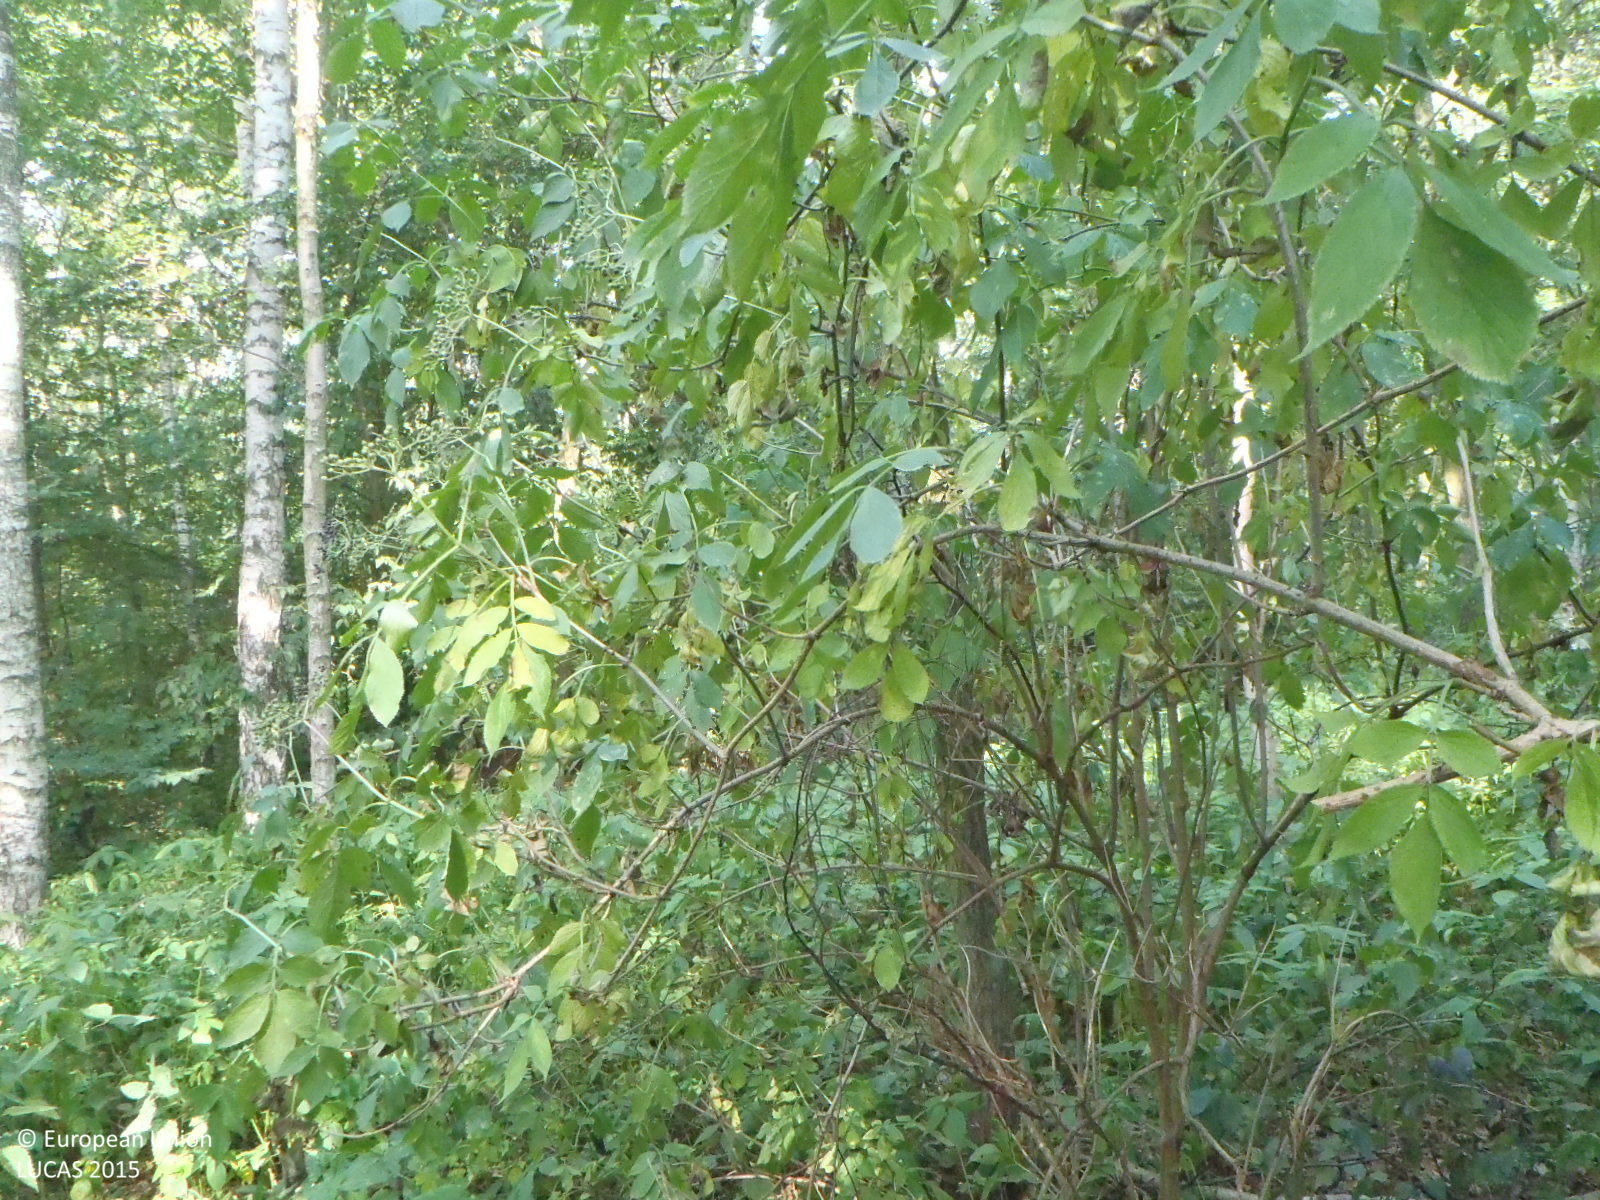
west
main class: Woodland
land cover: Broadleaved woodland
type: mesophytic deciduous forest
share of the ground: > 75 %
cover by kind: broadleaved forest trees 95 %, herbaceous plants 5 %
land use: Forestry
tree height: > 5 m
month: August
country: CZ
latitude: 50.7070
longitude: 14.5191
